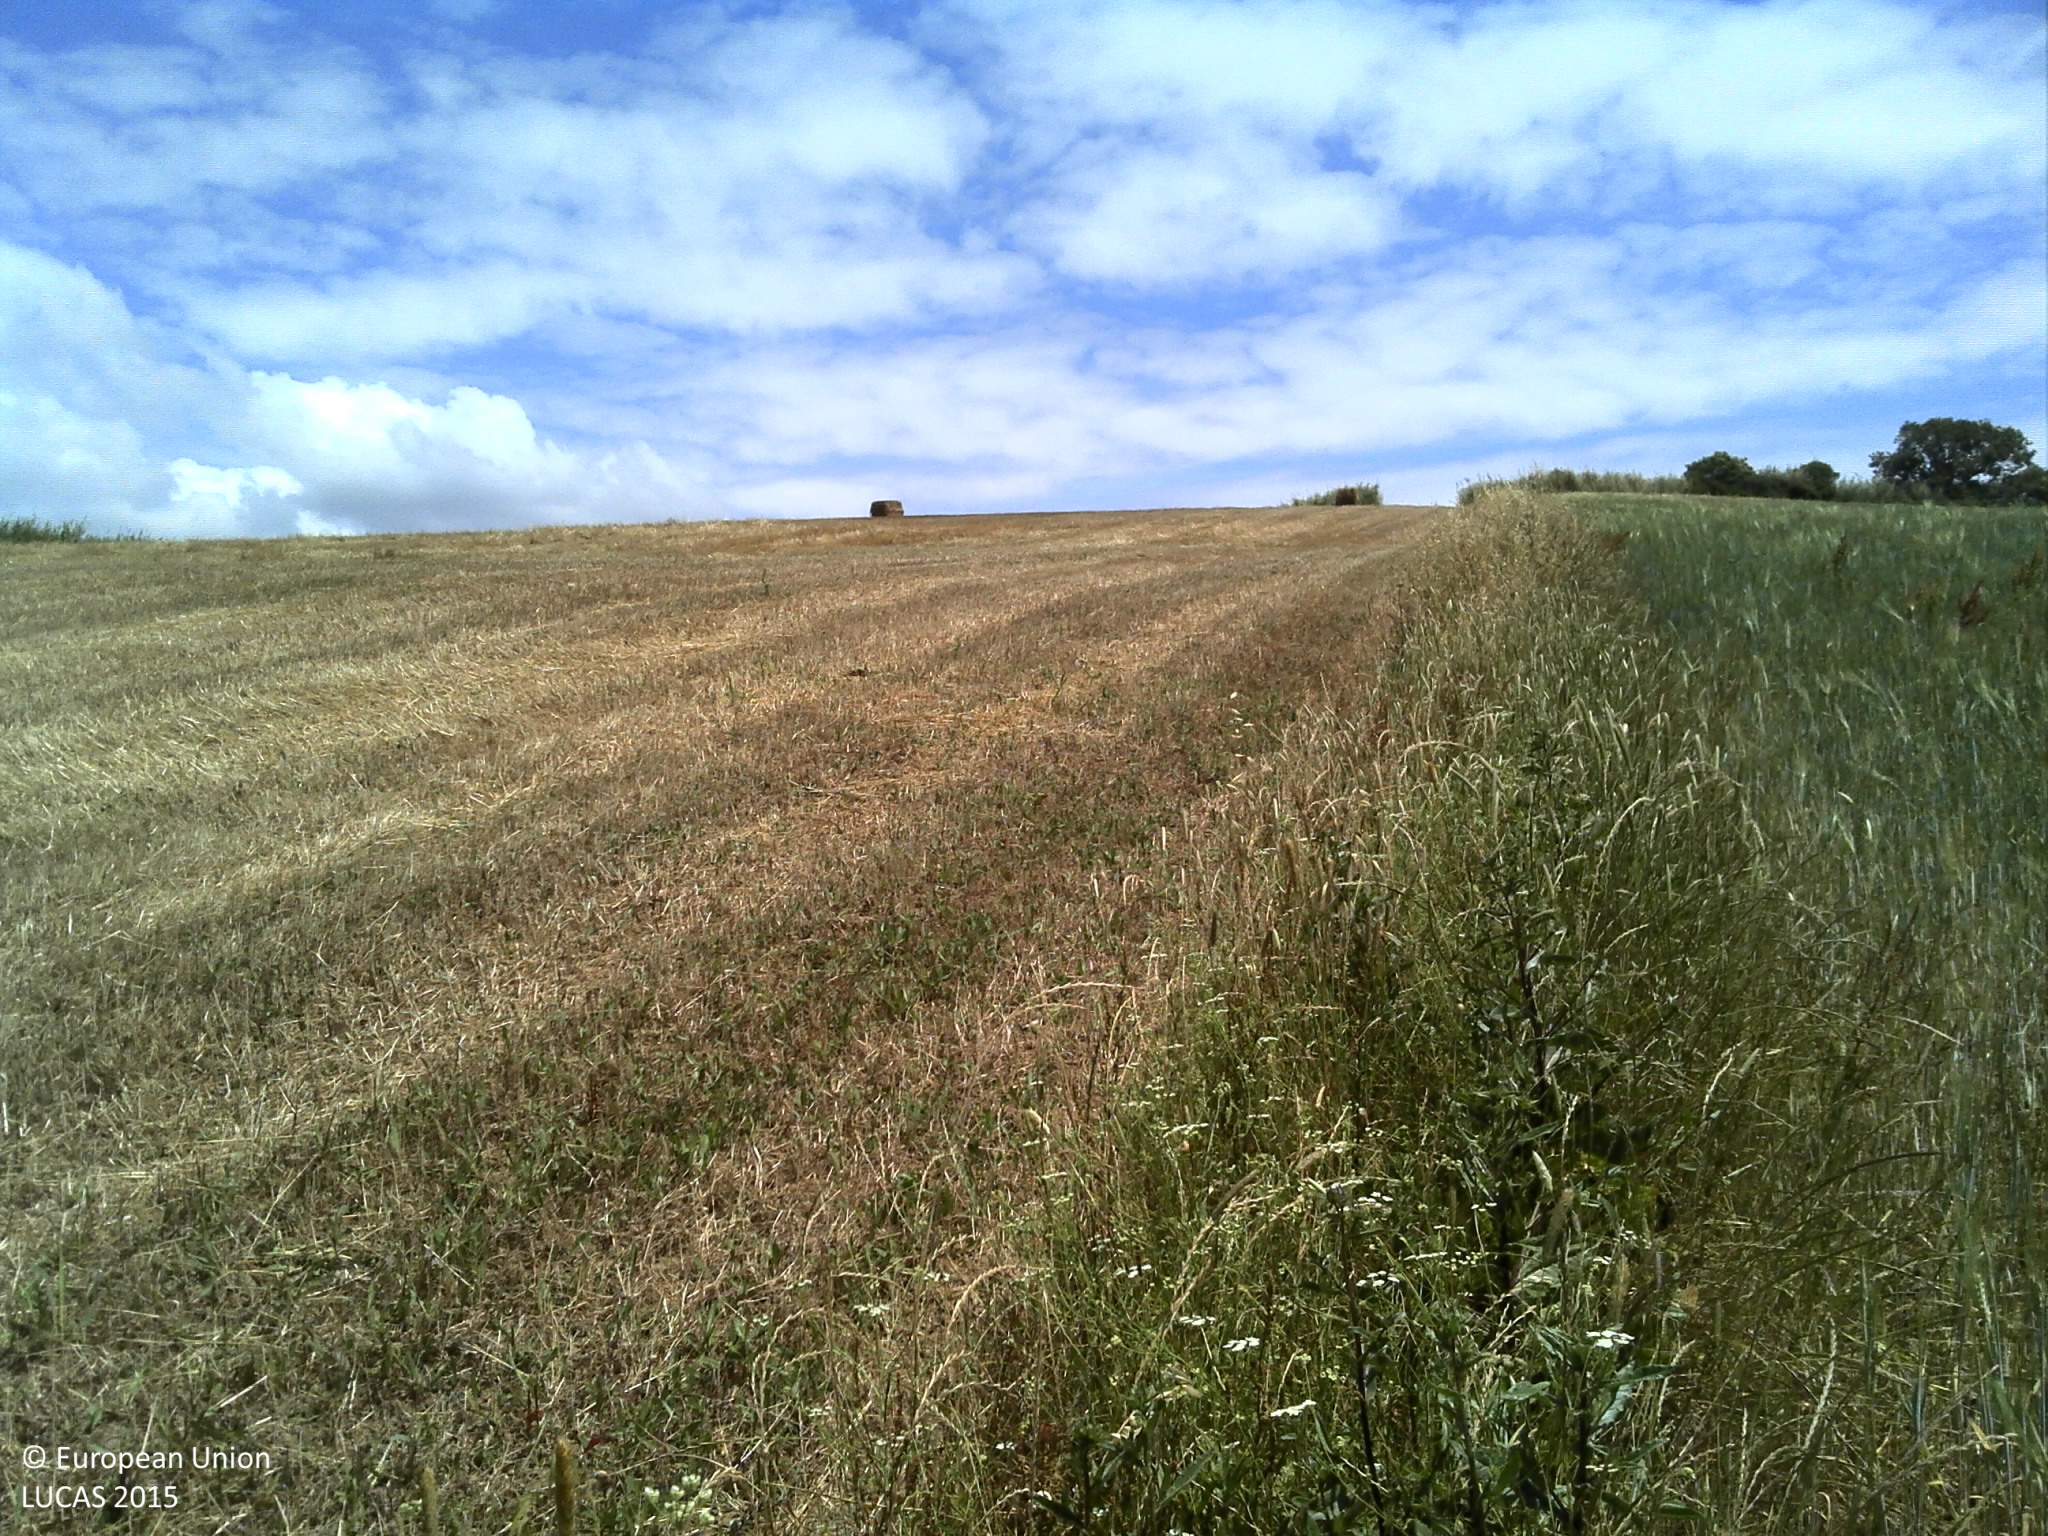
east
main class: Cropland
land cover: Triticale
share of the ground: 50 - 75 %
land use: Agriculture (excluding fallow land and kitchen gardens)
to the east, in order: Triticale; Shruby margins; Oats; Pine dominated coniferous woodland; Shrubland without tree cover; Grassland without tree/shrub cover
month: June
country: PT
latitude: 39.2411
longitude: -9.2884
